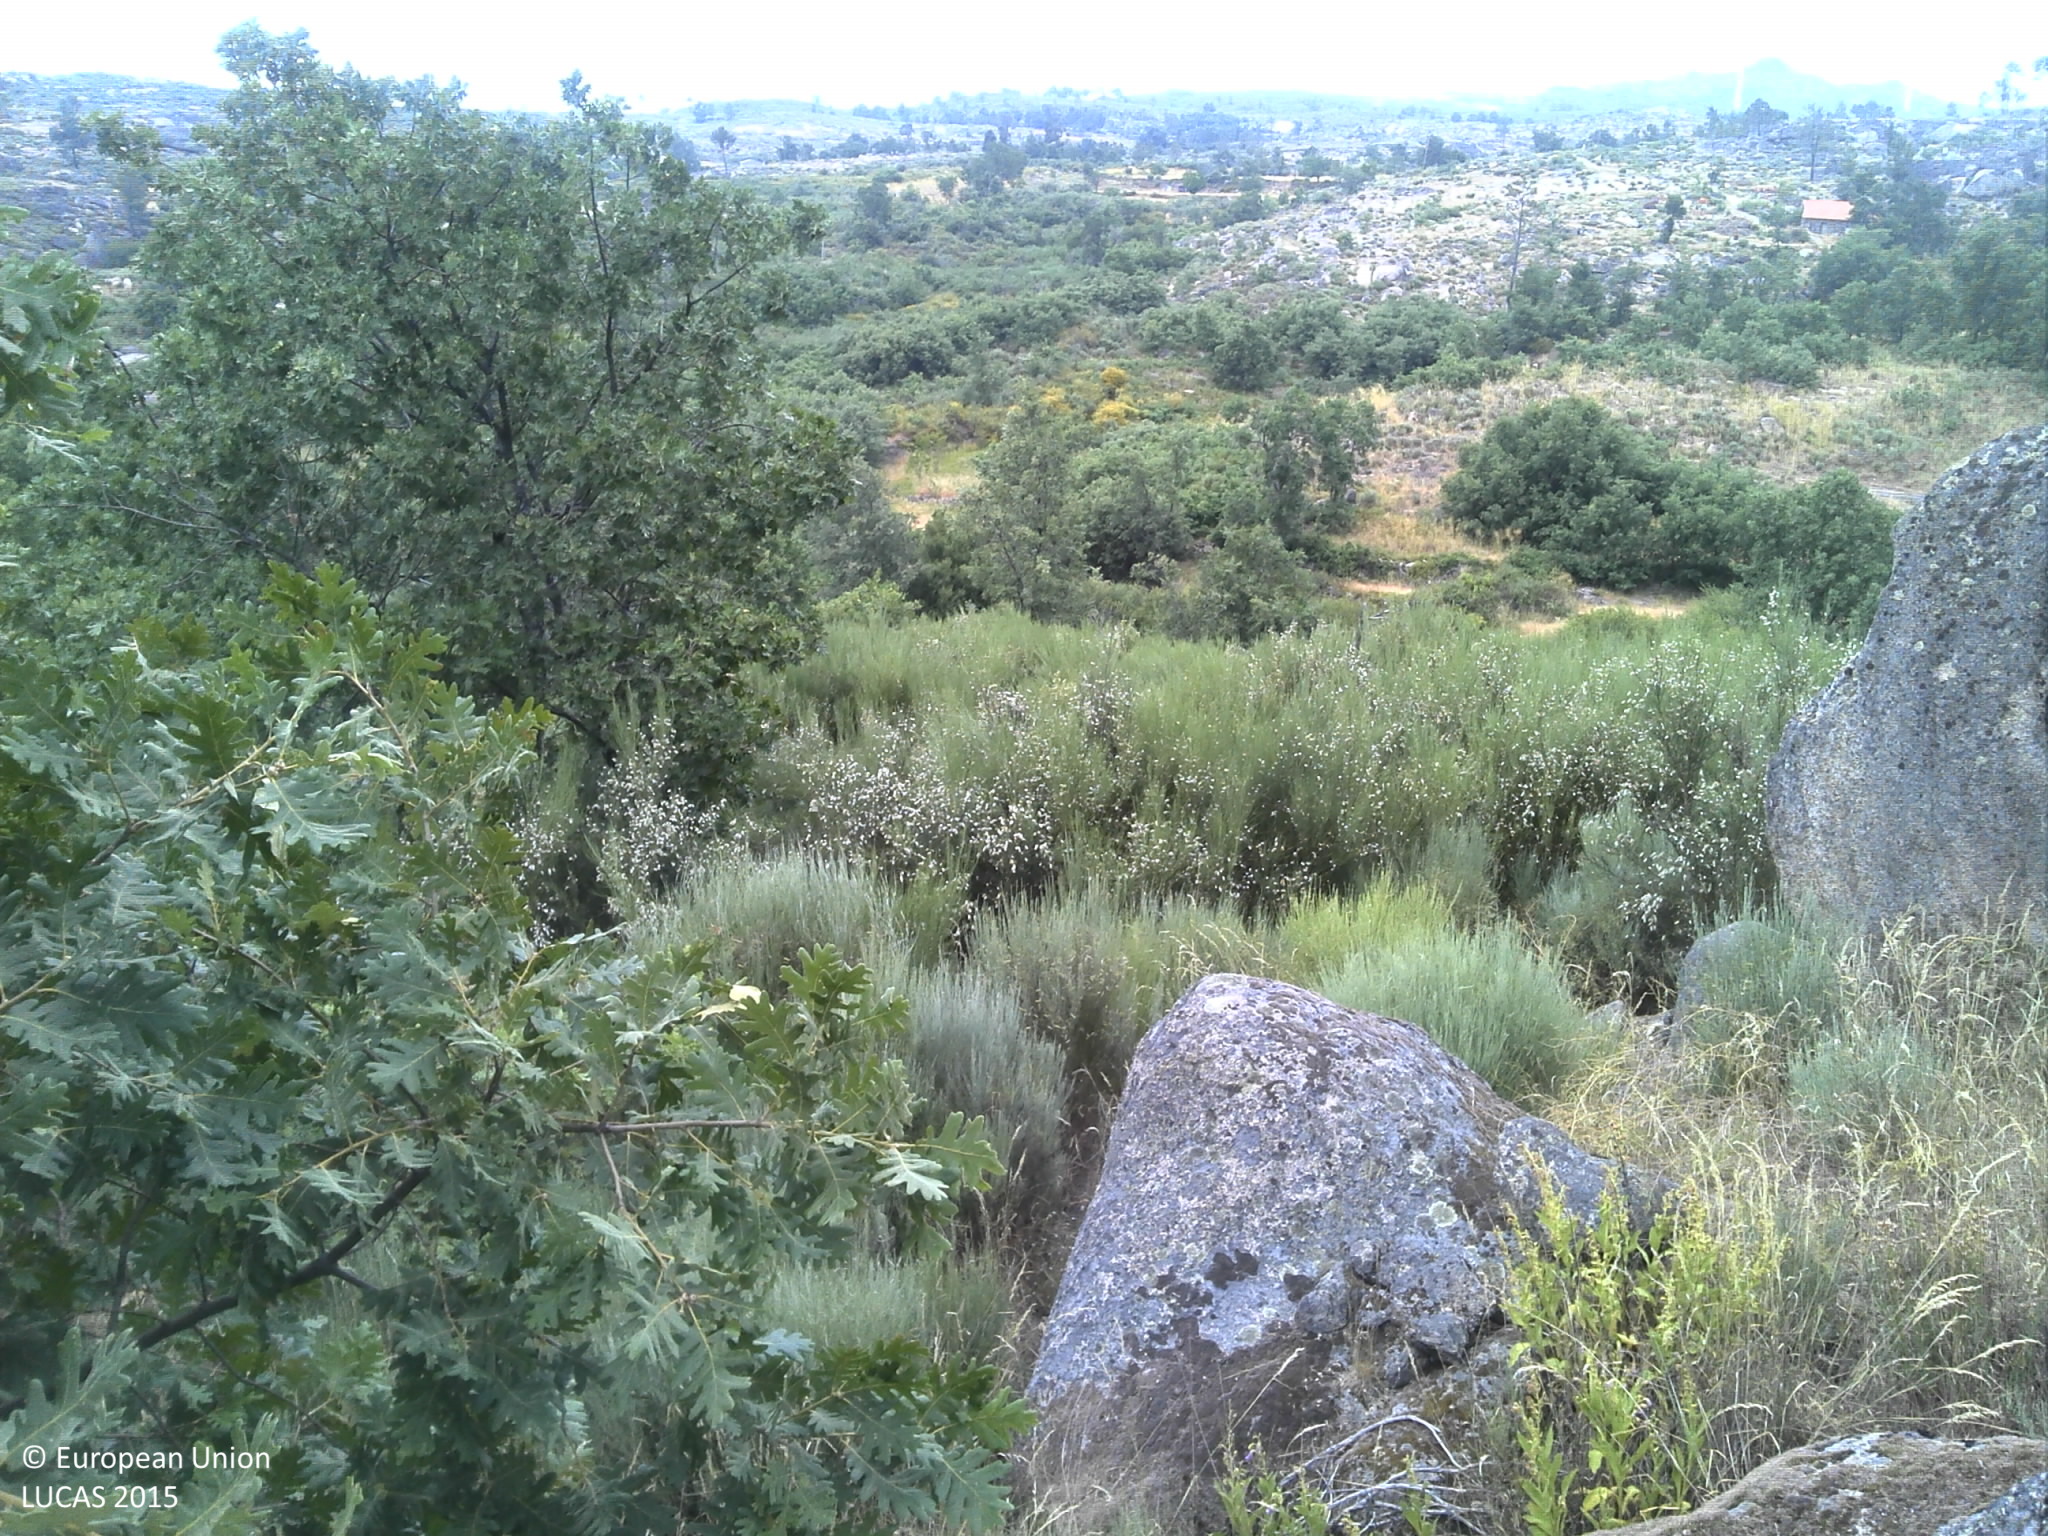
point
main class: Shrubland
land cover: Shrubland with sparse tree cover
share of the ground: 50 - 75 %
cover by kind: shrubs 60 %, herbaceous plants 15 %, consolidated bare surface 10 %, unconsolidated bare surface 10 %, broadleaved forest trees 5 %
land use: Abandoned areas
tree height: > 5 m
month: June
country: PT
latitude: 40.3216
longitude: -7.2005
